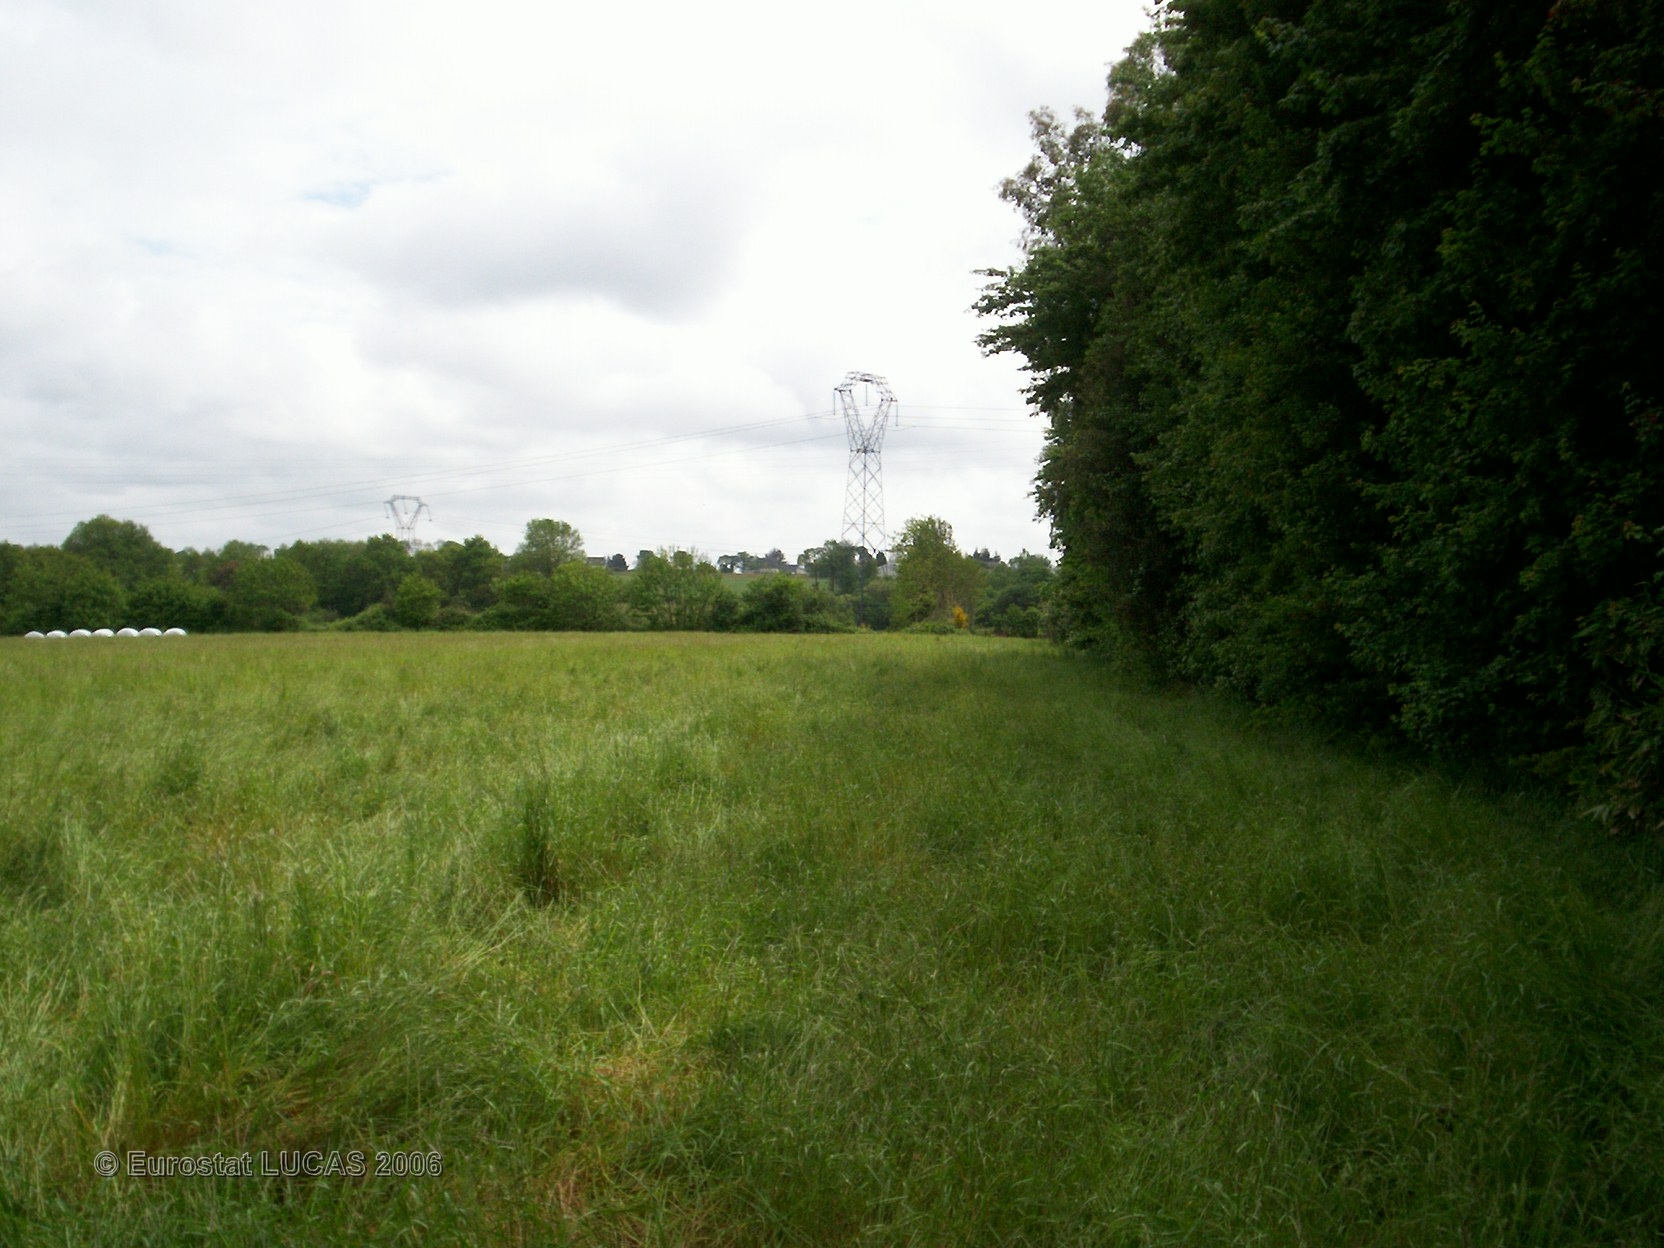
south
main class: Grassland
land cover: Grassland without tree/shrub cover
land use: Agriculture (excluding fallow land and kitchen gardens)
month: May
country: FR
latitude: 47.9145
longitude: -3.5240
